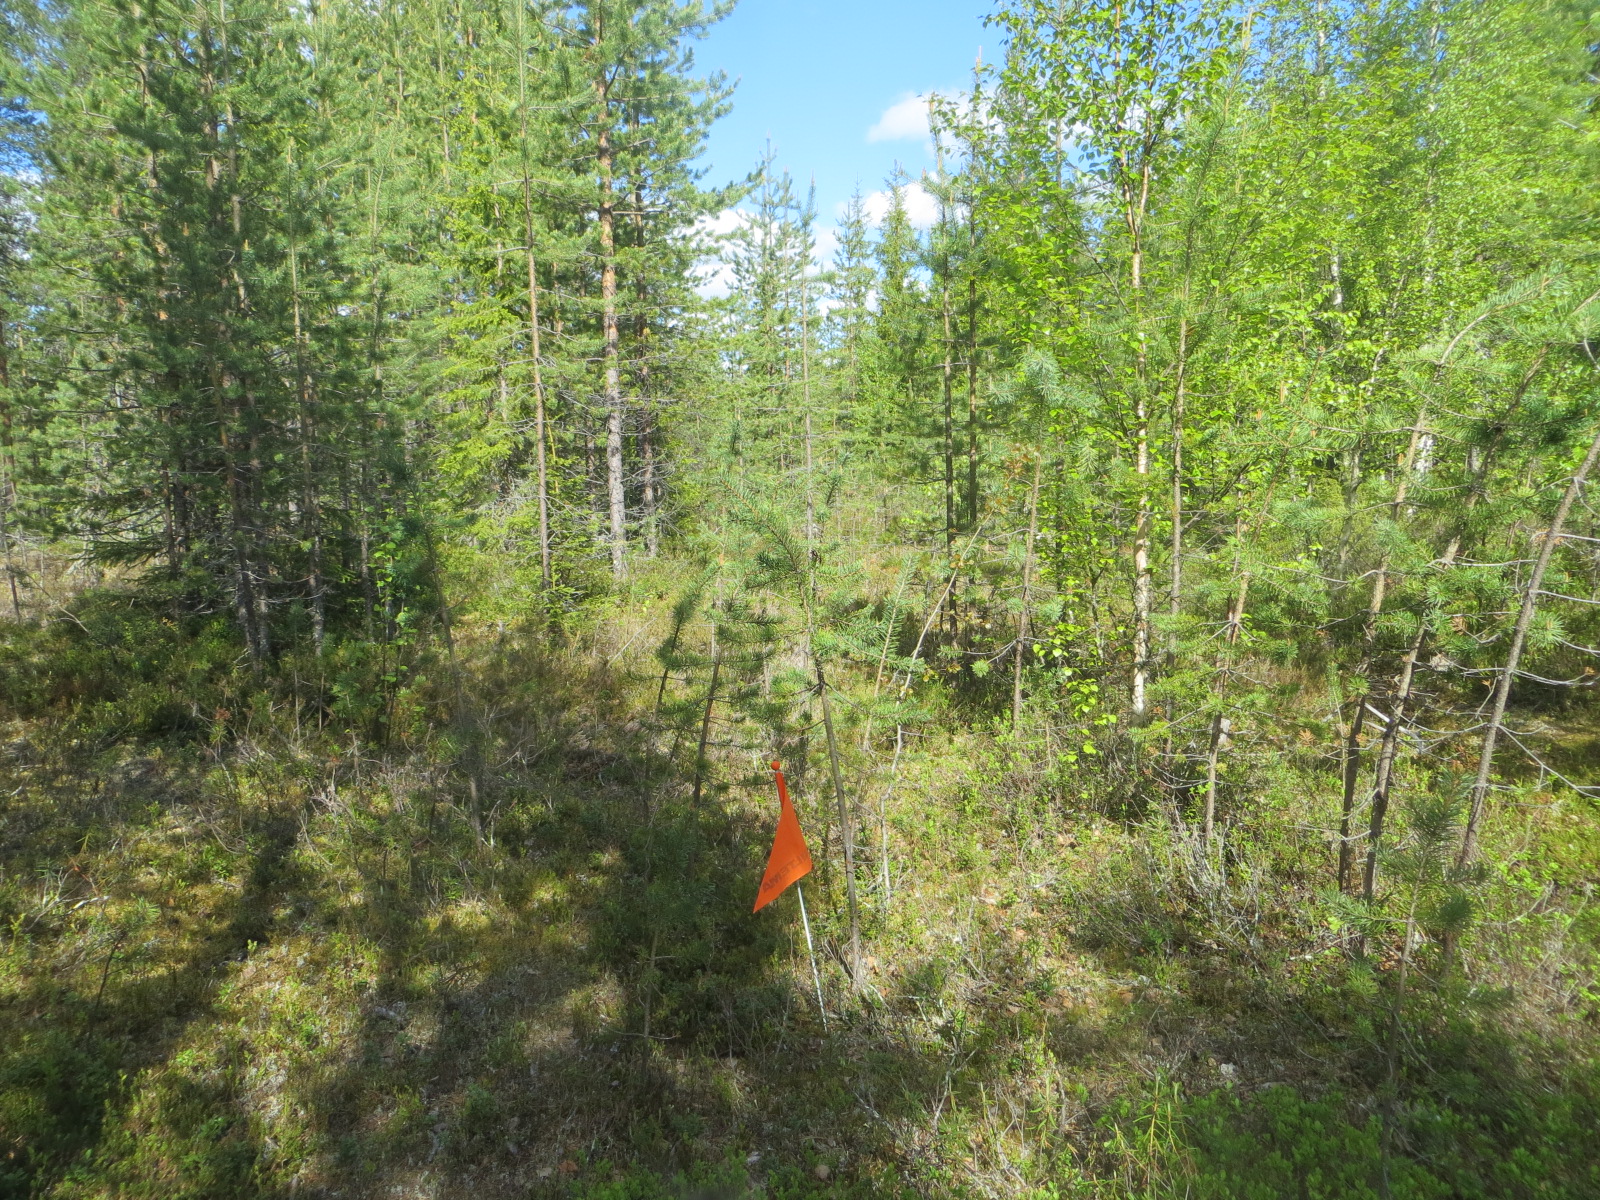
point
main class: Woodland
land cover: Other mixed woodland
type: boreal forest
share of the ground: > 75 %
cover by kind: coniferous forest trees 50 %, broadleaved forest trees 30 %, shrubs 20 %
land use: Forestry
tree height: > 5 m
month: June
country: FI
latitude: 66.9170
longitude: 25.3925
